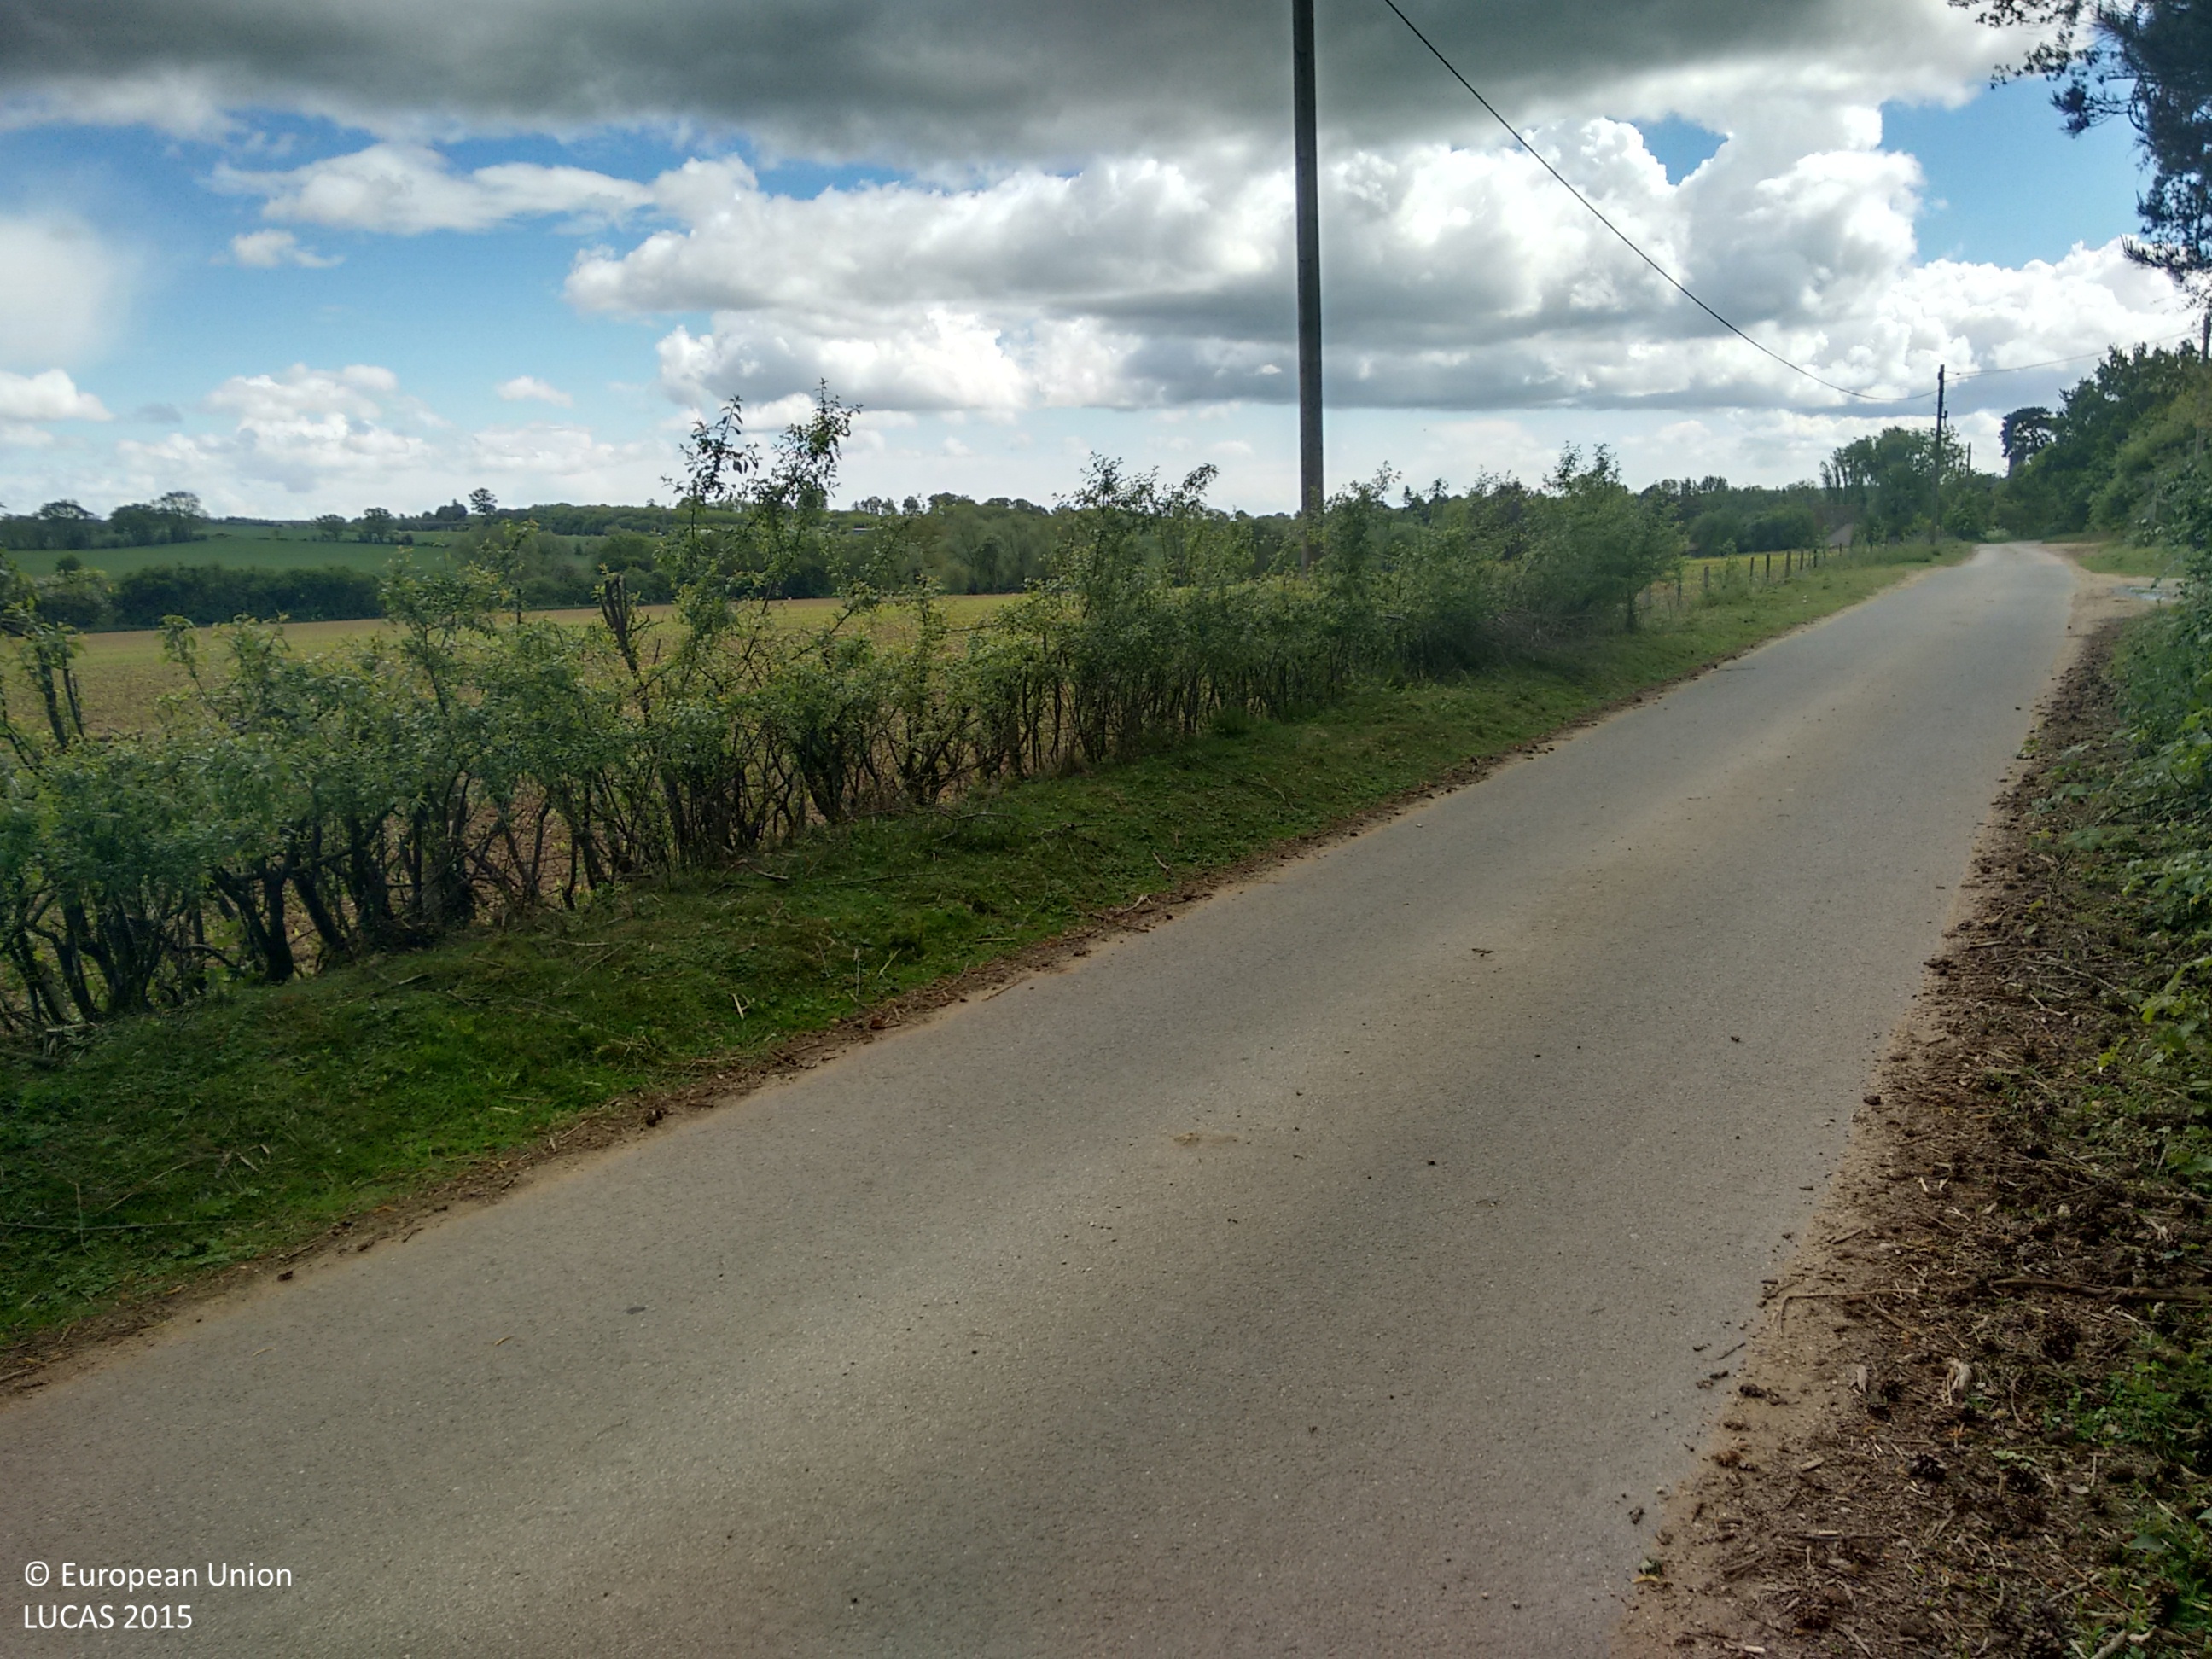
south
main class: Woodland
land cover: Broadleaved woodland
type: mesophytic deciduous forest
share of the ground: > 75 %
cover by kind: broadleaved forest trees 80 %, shrubs 20 %
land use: Semi-natural and natural areas not in use
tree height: > 5 m
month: May
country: GB
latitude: 51.2030
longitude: 0.7717
